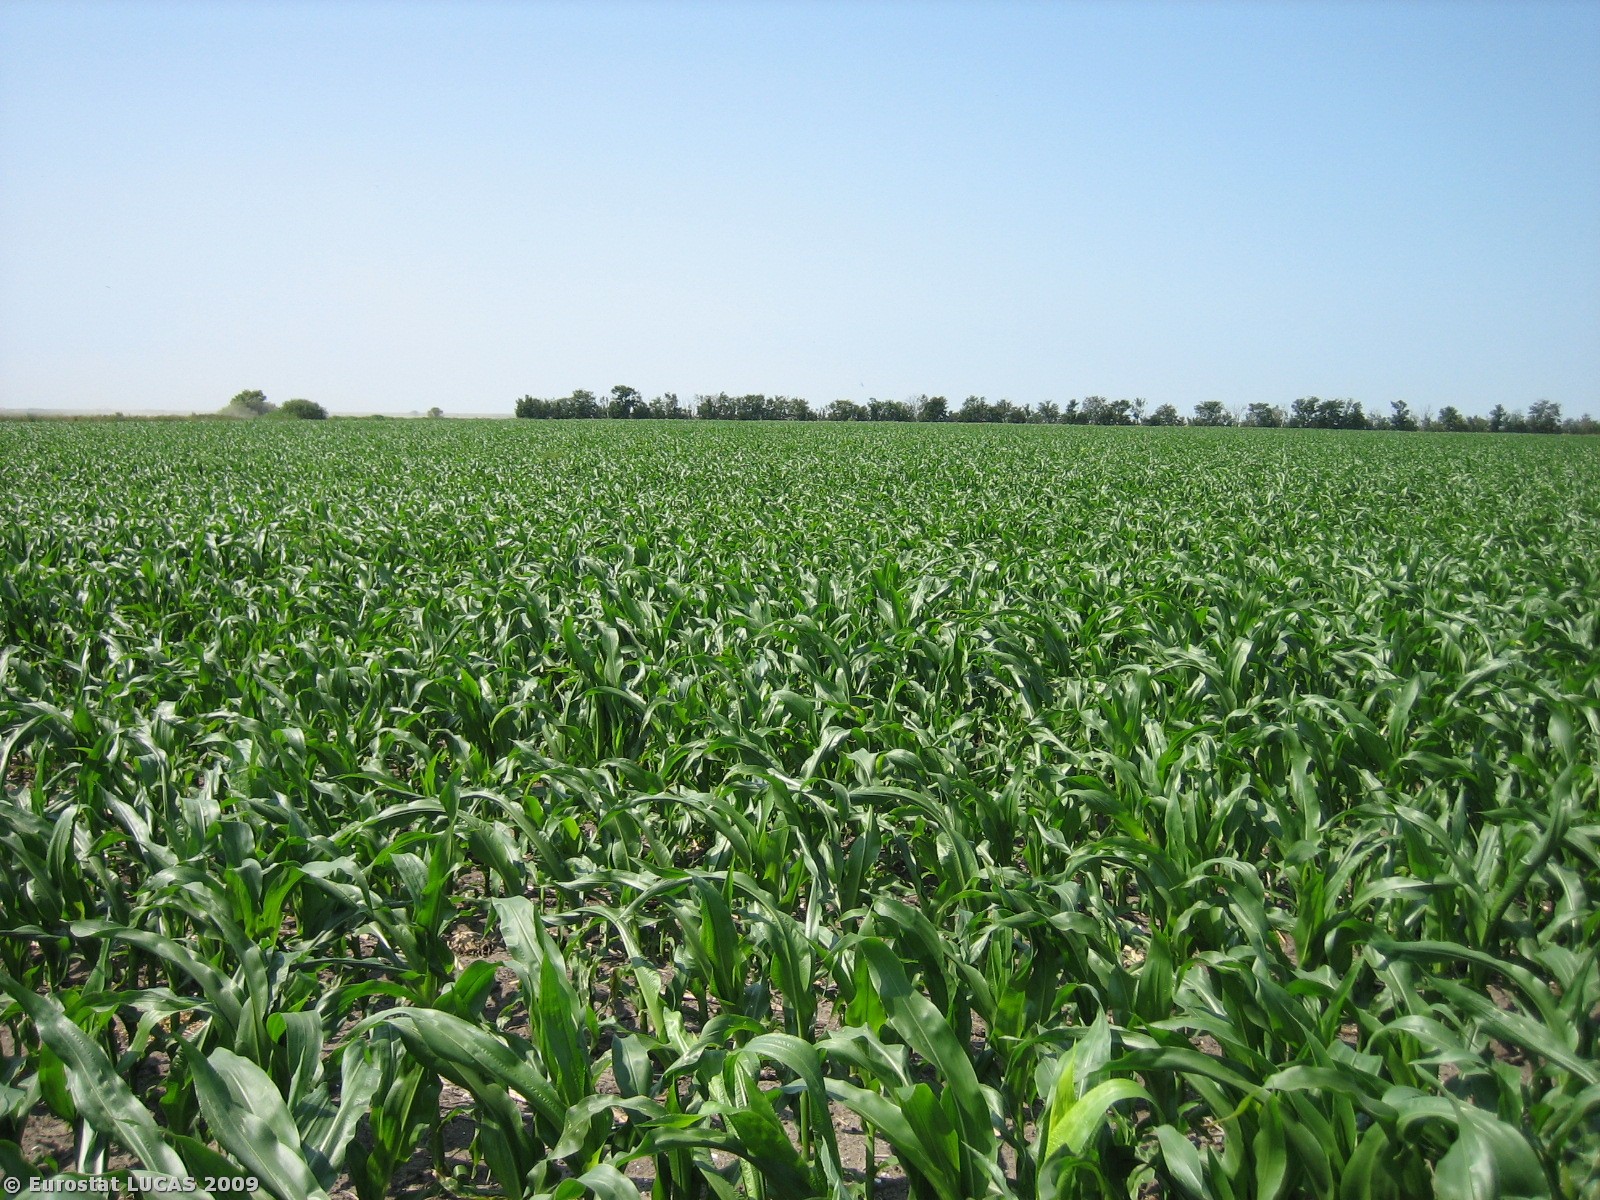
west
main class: Cropland
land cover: Maize
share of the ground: 50 - 75 %
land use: Agriculture (excluding fallow land and kitchen gardens)
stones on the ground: < 10 %
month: July
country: DK
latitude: 55.3545
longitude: 8.7235
